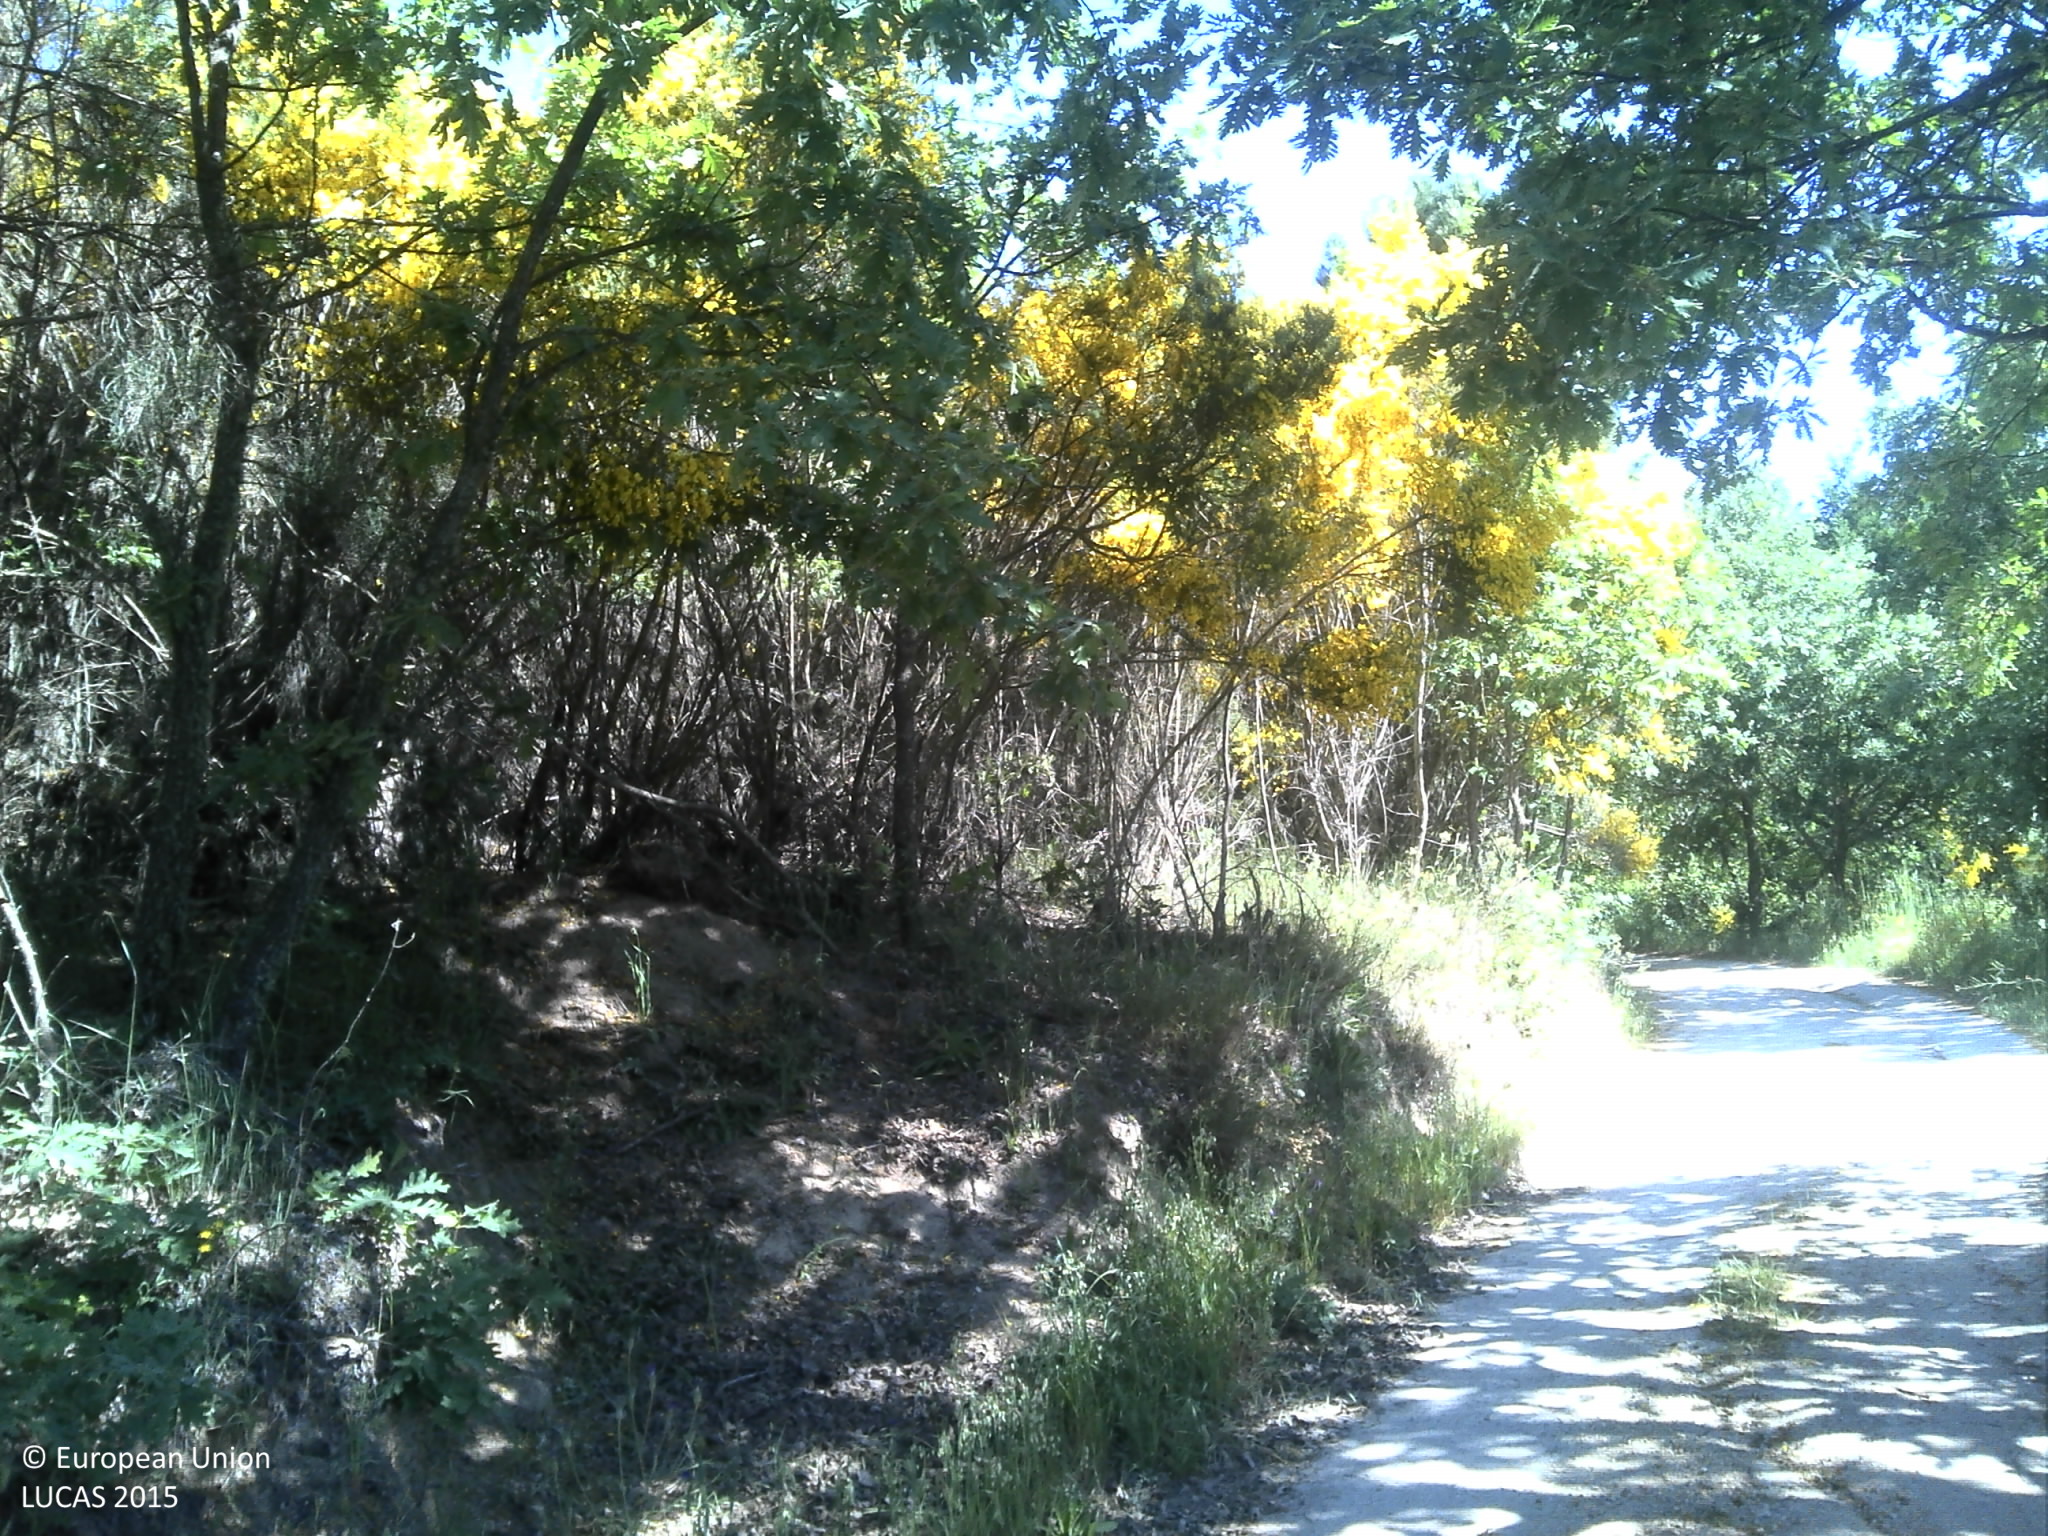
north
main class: Shrubland
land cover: Shrubland without tree cover
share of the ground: > 75 %
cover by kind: shrubs 80 %, herbaceous plants 10 %
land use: Semi-natural and natural areas not in use
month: May
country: PT
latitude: 40.5717
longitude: -7.2456
